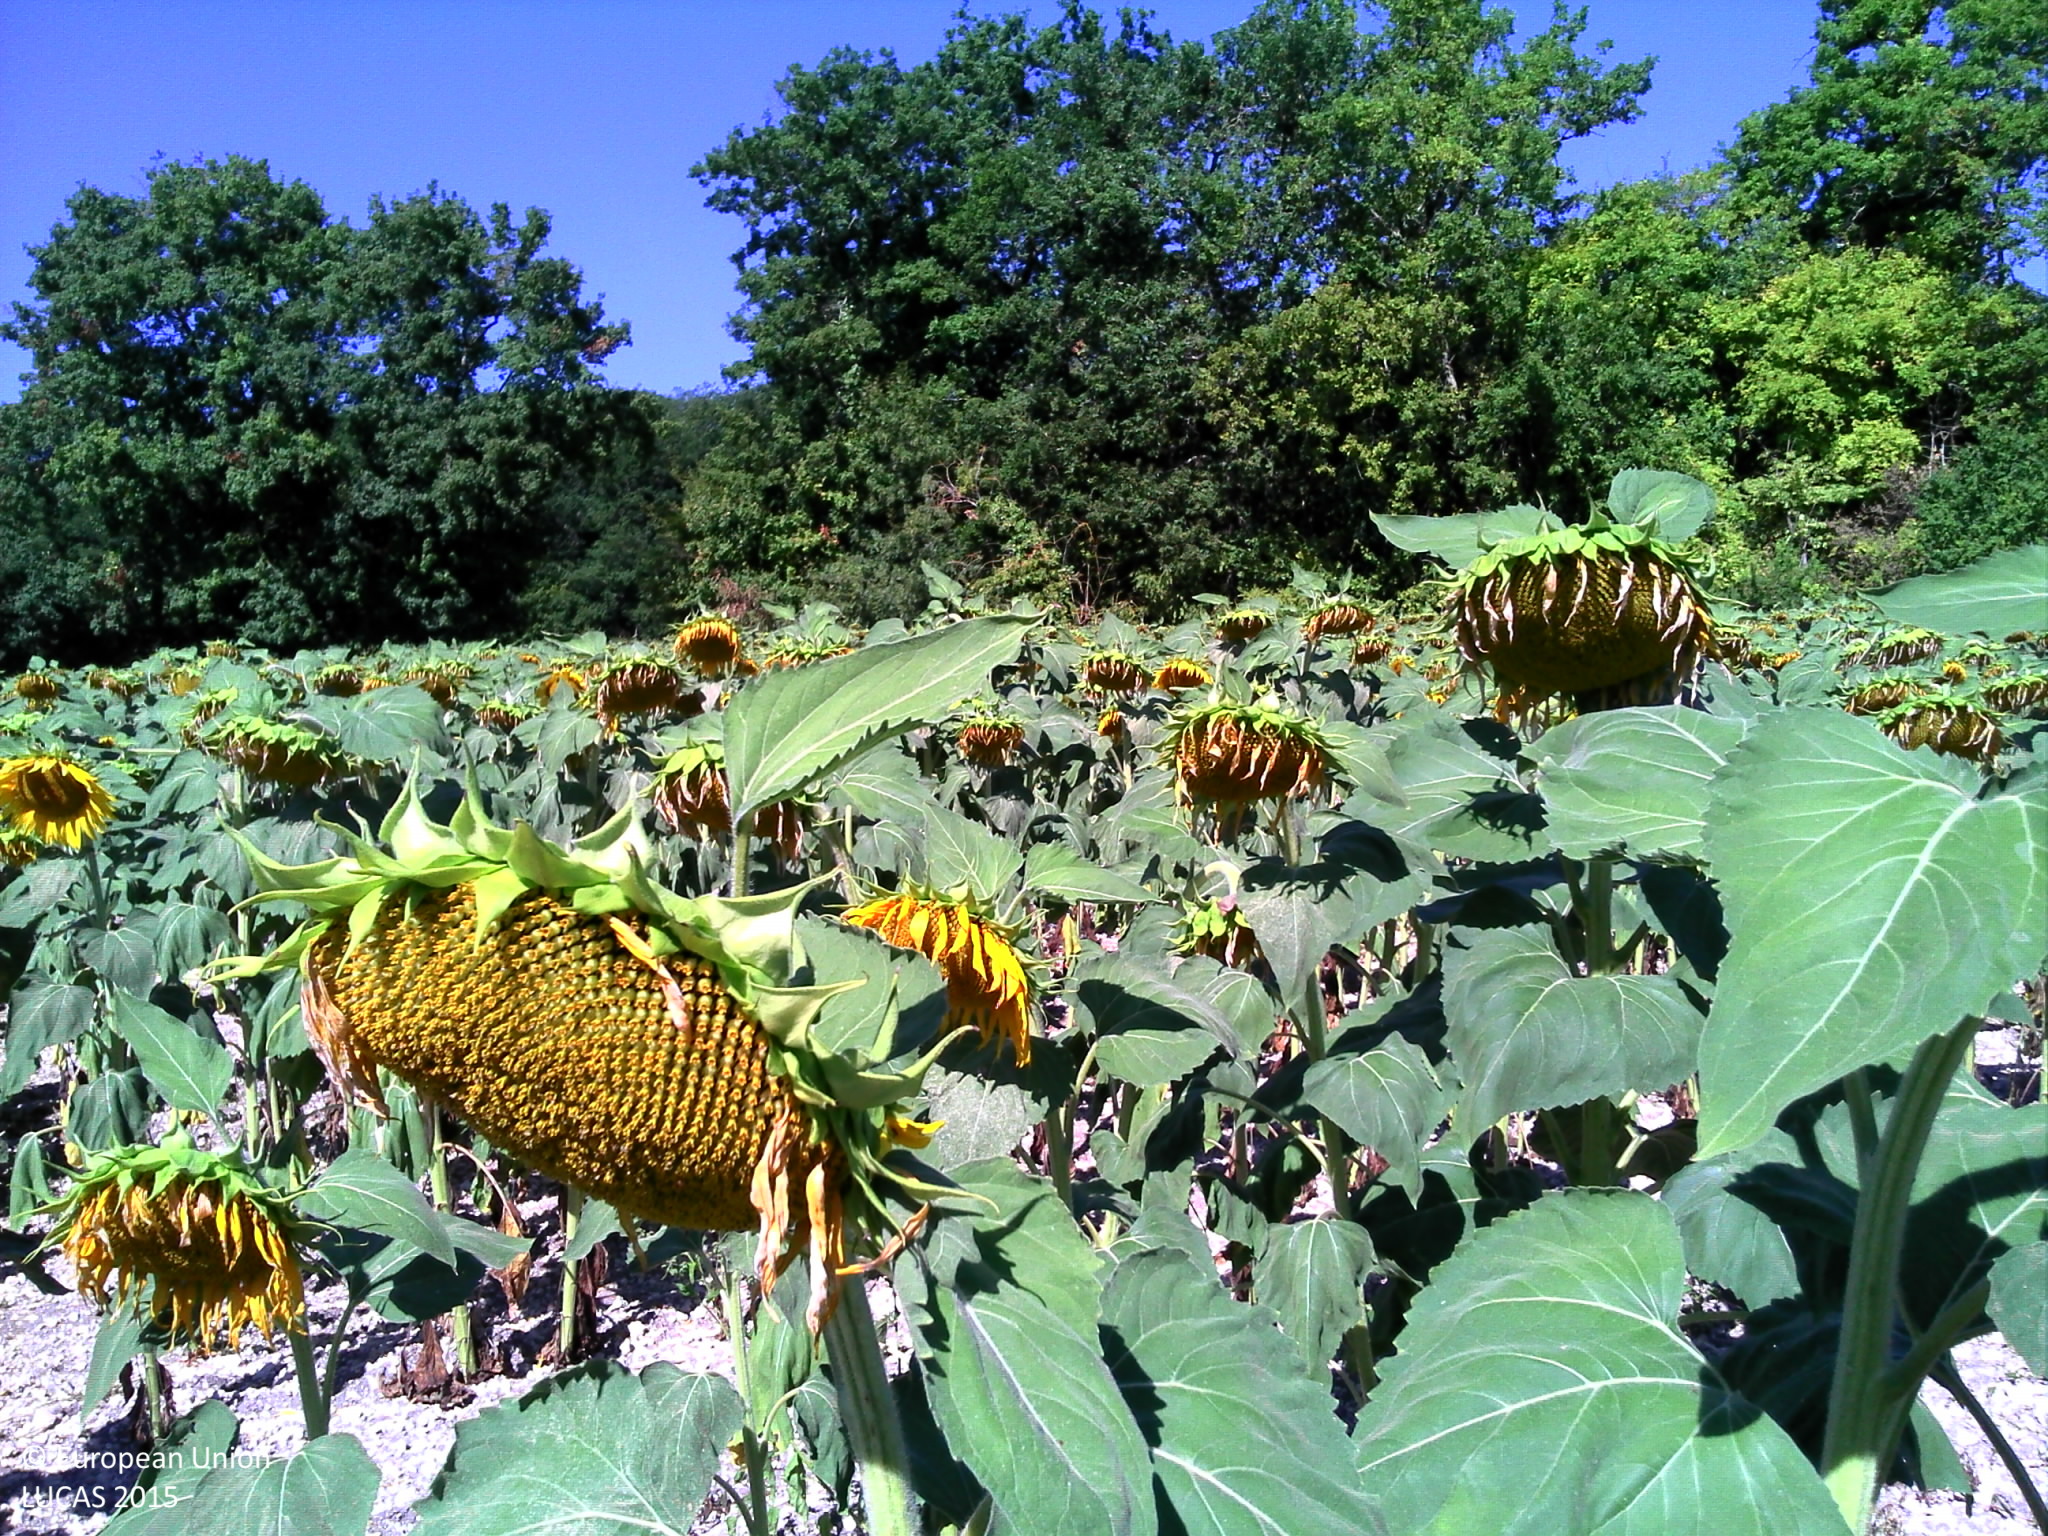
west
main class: Cropland
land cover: Sunflower
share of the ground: 50 - 75 %
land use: Agriculture (excluding fallow land and kitchen gardens)
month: July
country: FR
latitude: 44.7514
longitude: 0.5301
